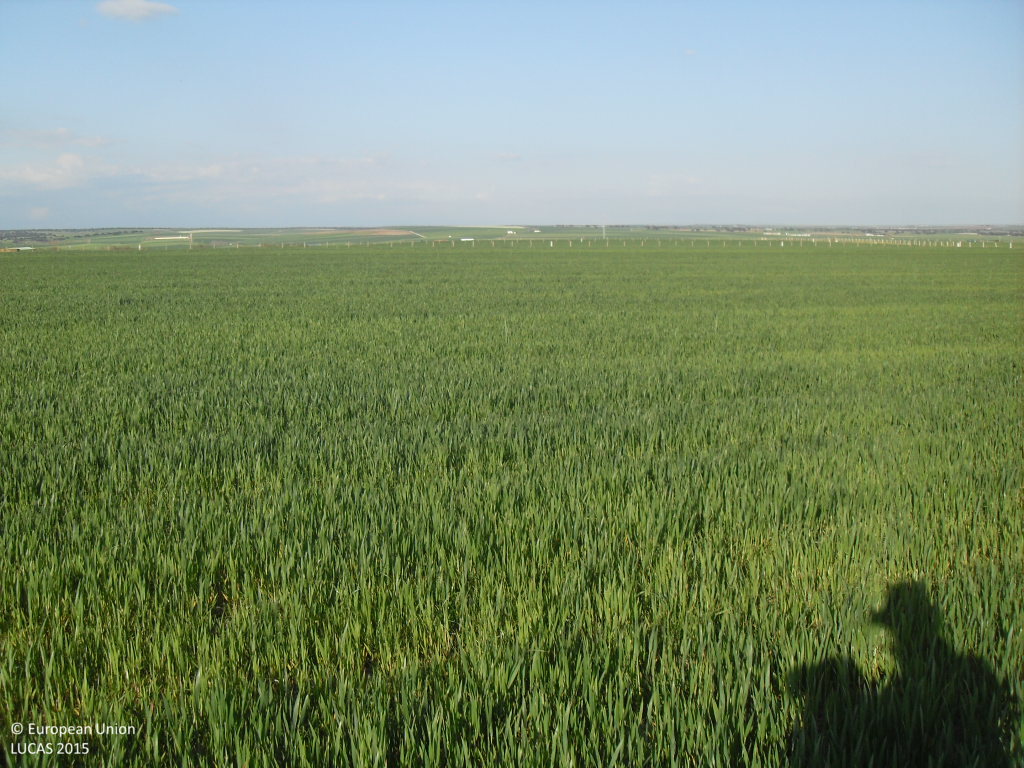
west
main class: Cropland
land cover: Oats
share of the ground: > 75 %
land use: Agriculture (excluding fallow land and kitchen gardens)
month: April
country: ES
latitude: 40.7551
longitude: -5.2635
